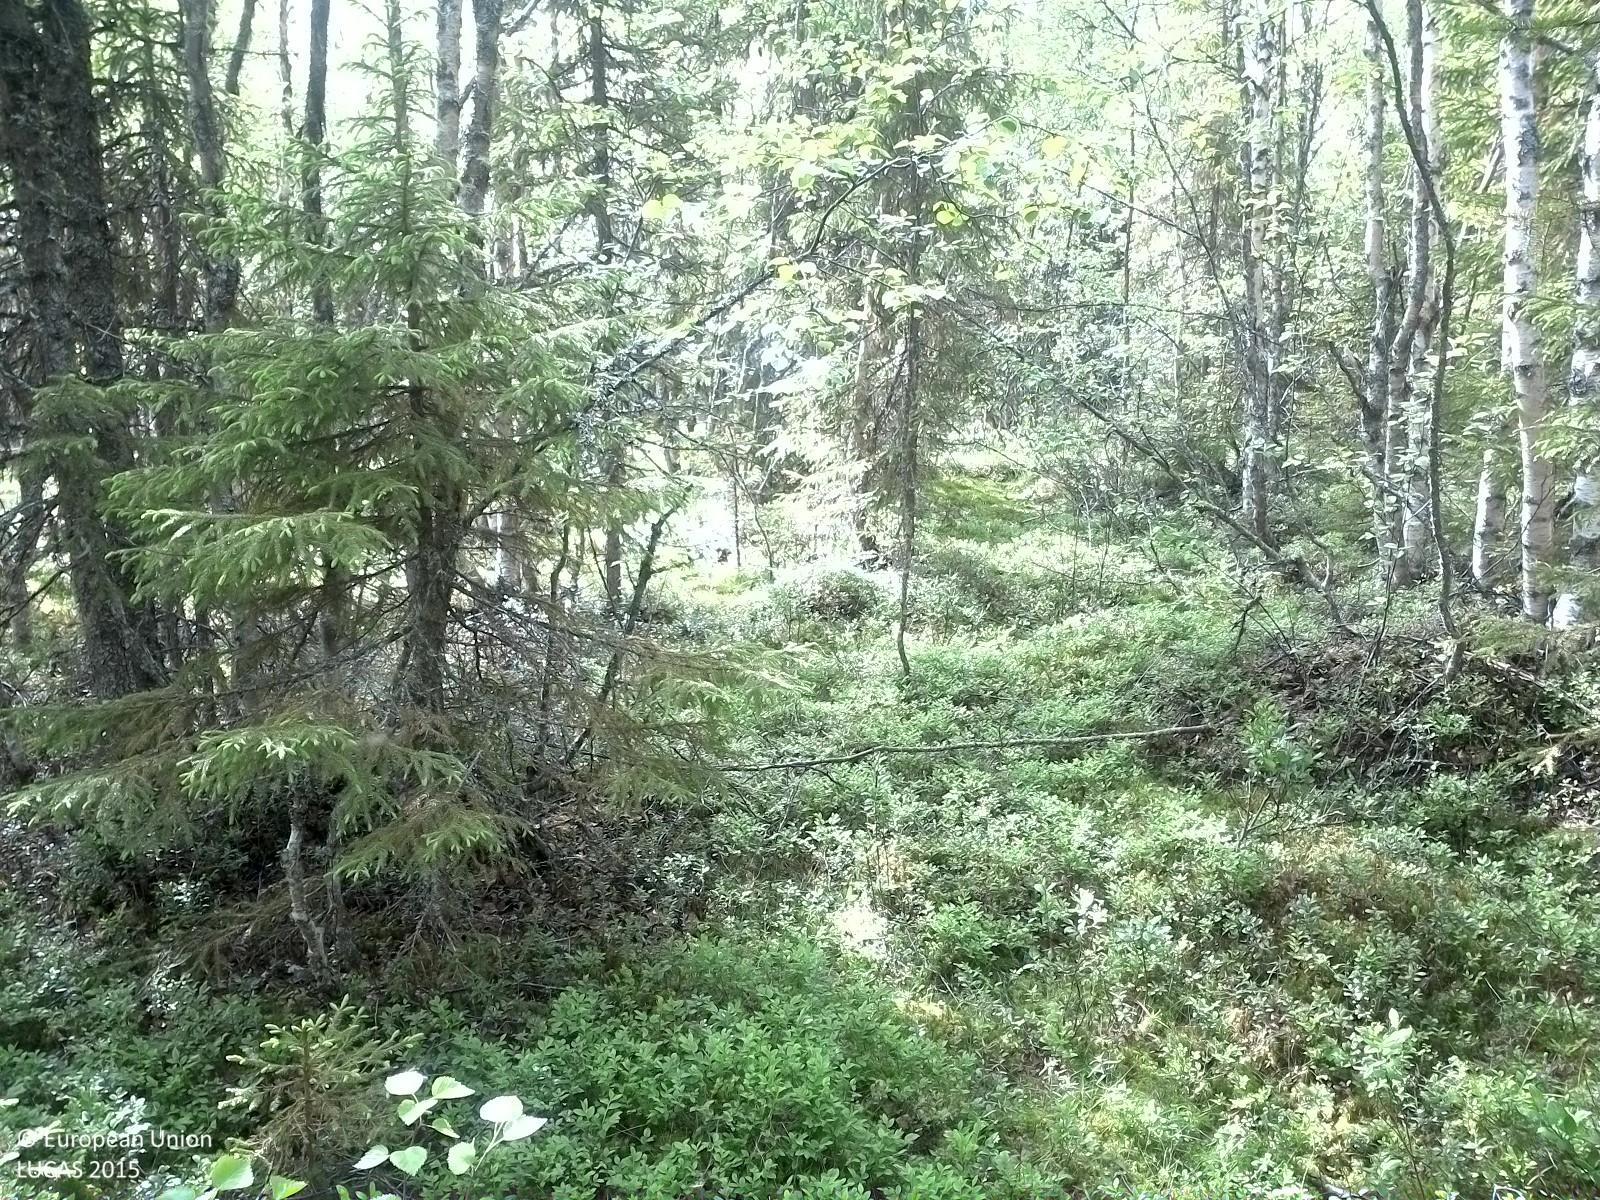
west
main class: Woodland
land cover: Spruce dominated mixed woodland
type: boreal forest
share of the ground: > 75 %
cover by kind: coniferous forest trees 65 %, broadleaved forest trees 25 %, shrubs 10 %
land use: Forestry
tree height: > 5 m
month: June
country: SE
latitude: 63.5314
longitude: 15.3046
